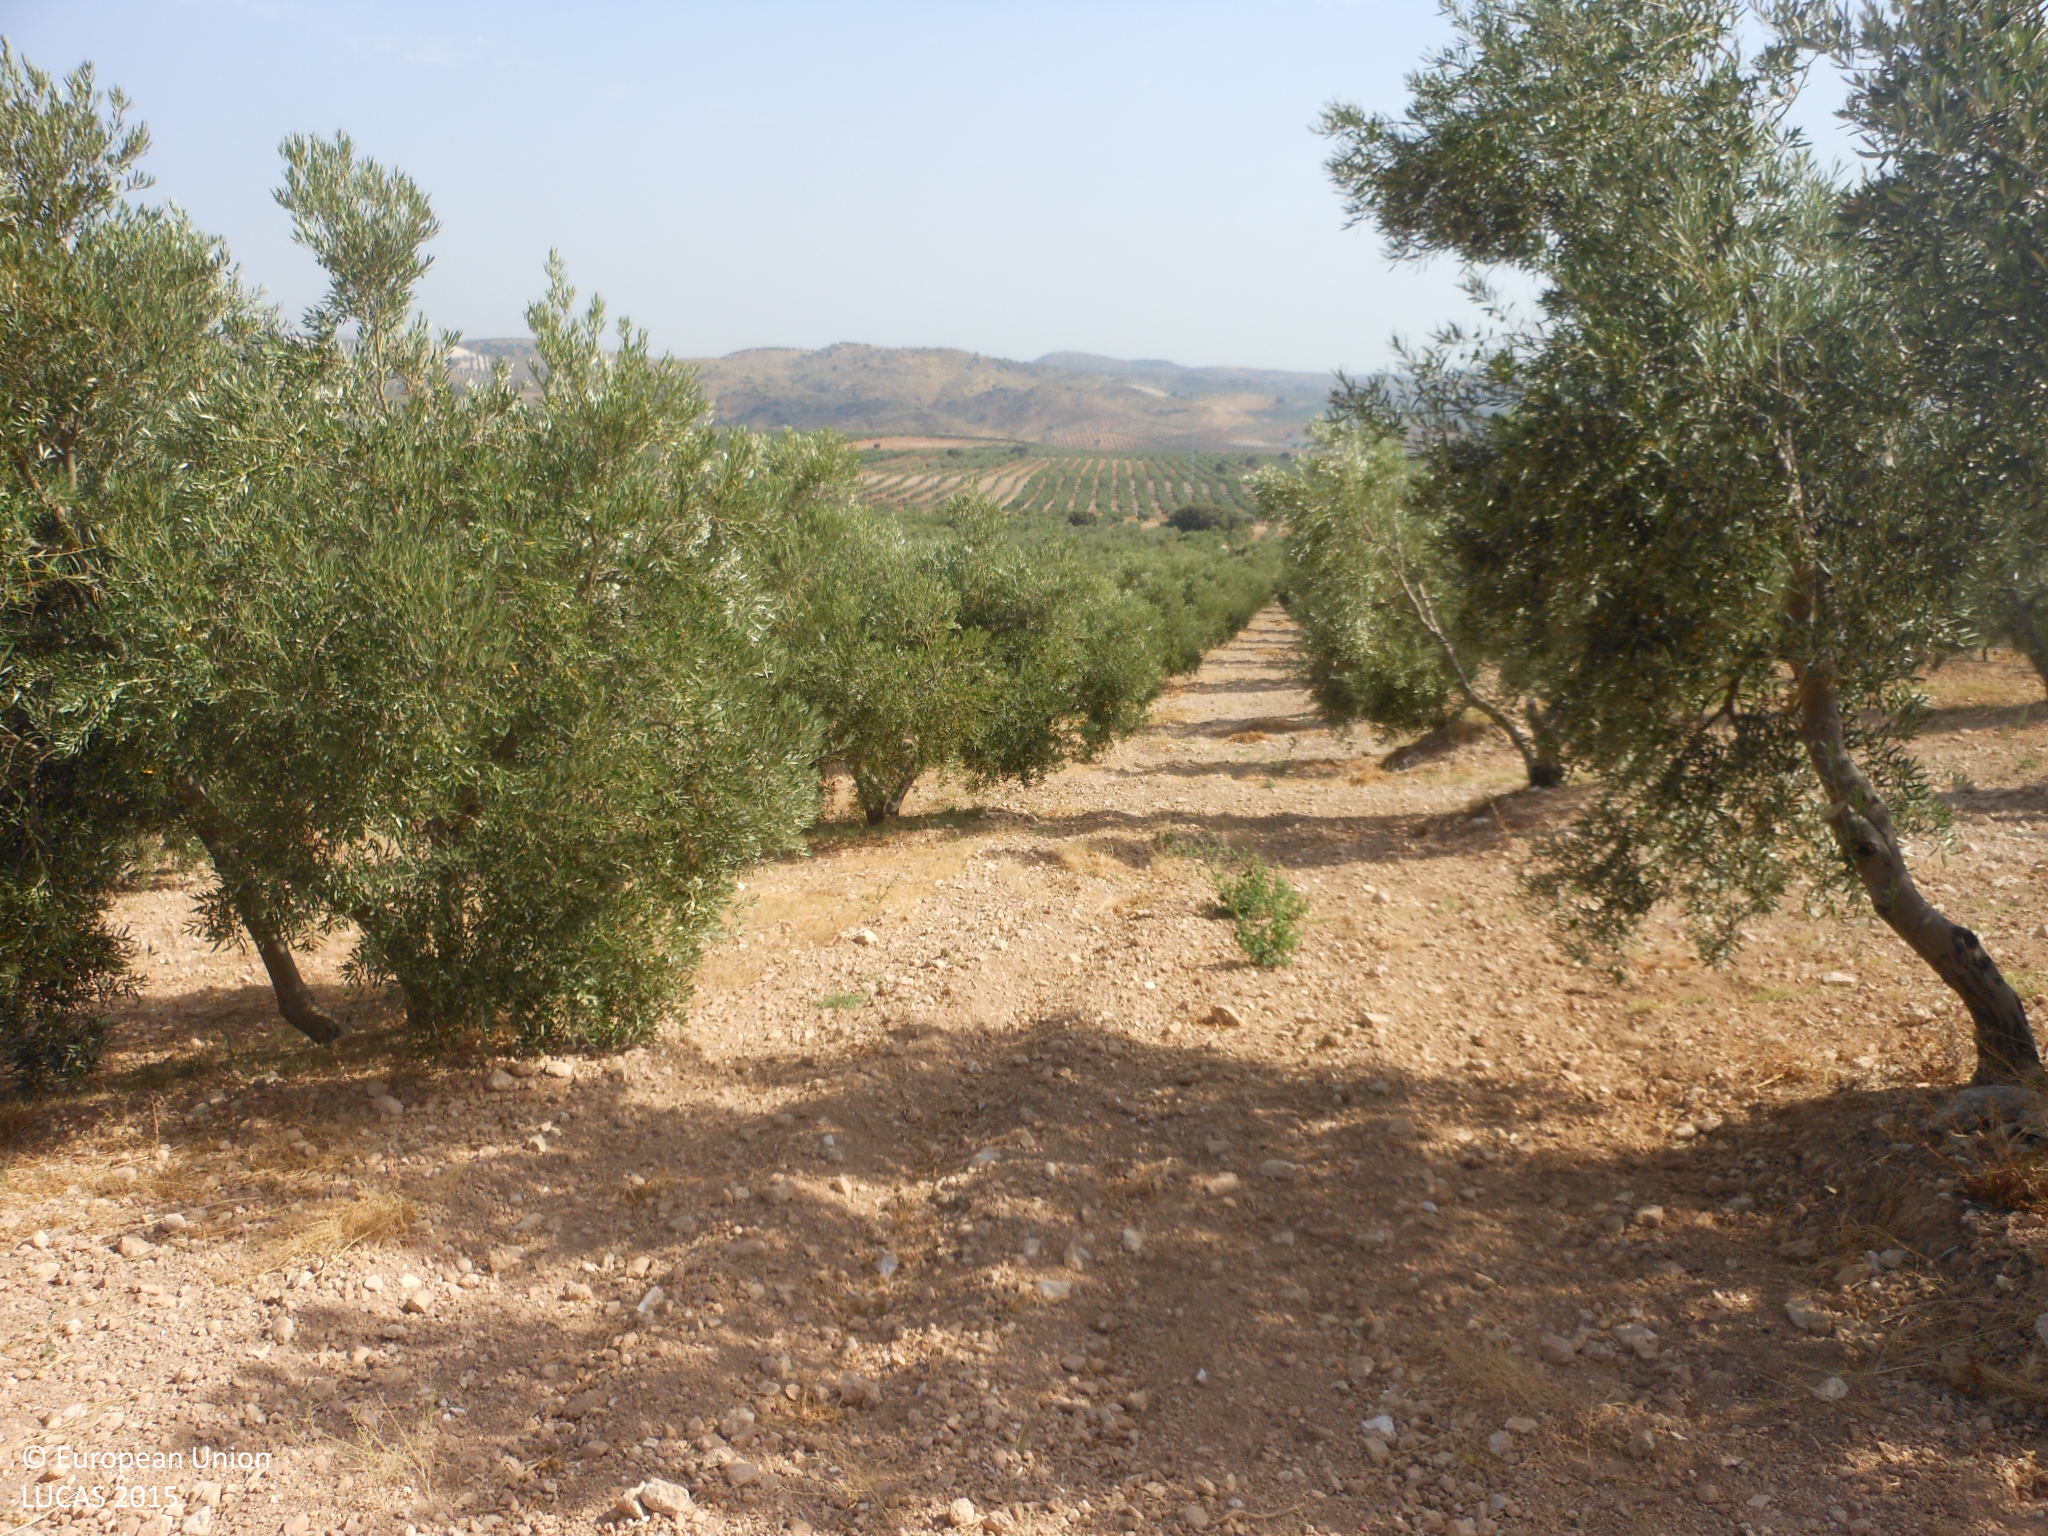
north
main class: Cropland
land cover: Olive groves
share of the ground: 25 - 50 %
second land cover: Other bare soil
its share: > 75 %
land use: Agriculture (excluding fallow land and kitchen gardens)
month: July
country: ES
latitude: 37.0987
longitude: -5.0248
